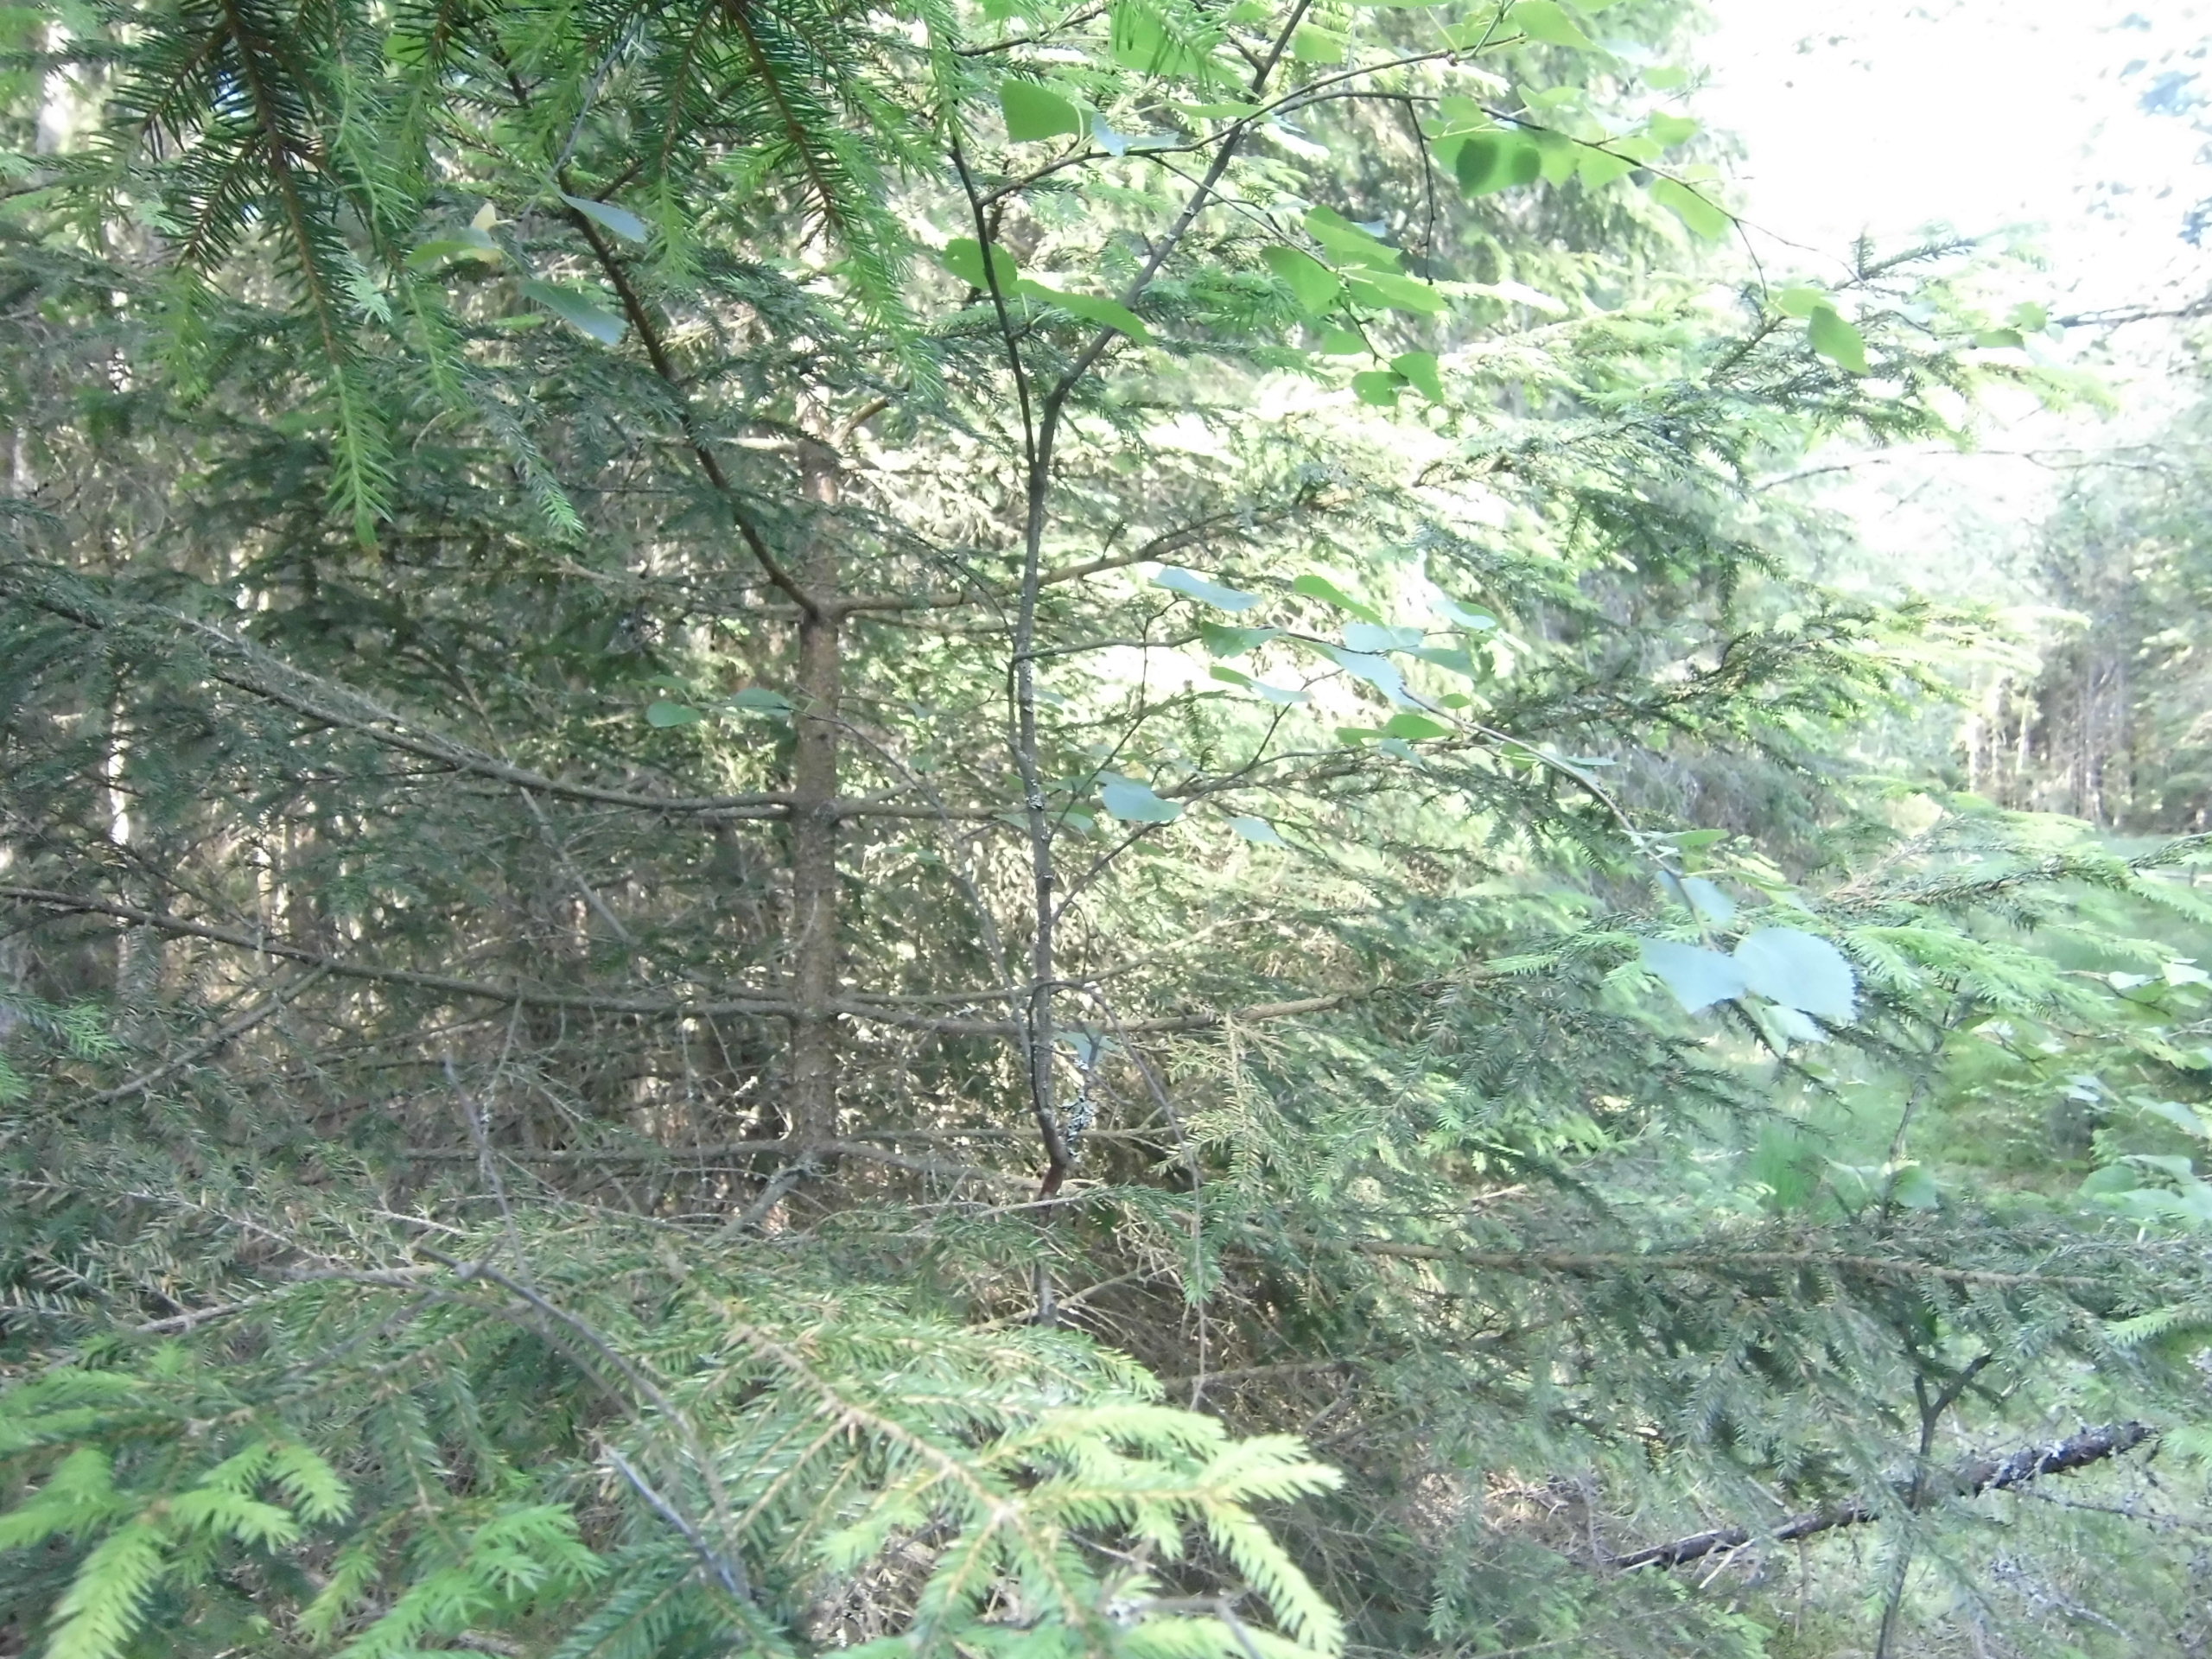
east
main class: Woodland
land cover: Spruce dominated coniferous woodland
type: boreal forest
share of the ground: 50 - 75 %
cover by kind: coniferous forest trees 55 %, herbaceous plants 20 %, broadleaved forest trees 10 %, lichens and mosses 10 %, shrubs 5 %
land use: Forestry
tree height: > 5 m
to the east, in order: Spruce dominated coniferous woodland; Ditches and canals; Spruce dominated coniferous woodland; Spruce dominated mixed woodland; Spruce dominated coniferous woodland; Ditches and canals; Spruce dominated mixed woodland; Rivers and streams; Spruce dominated mixed woodland; Paved roads, cycling and walking lanes; Spruce dominated mixed woodland
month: July
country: SE
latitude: 57.3805
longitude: 14.7032
